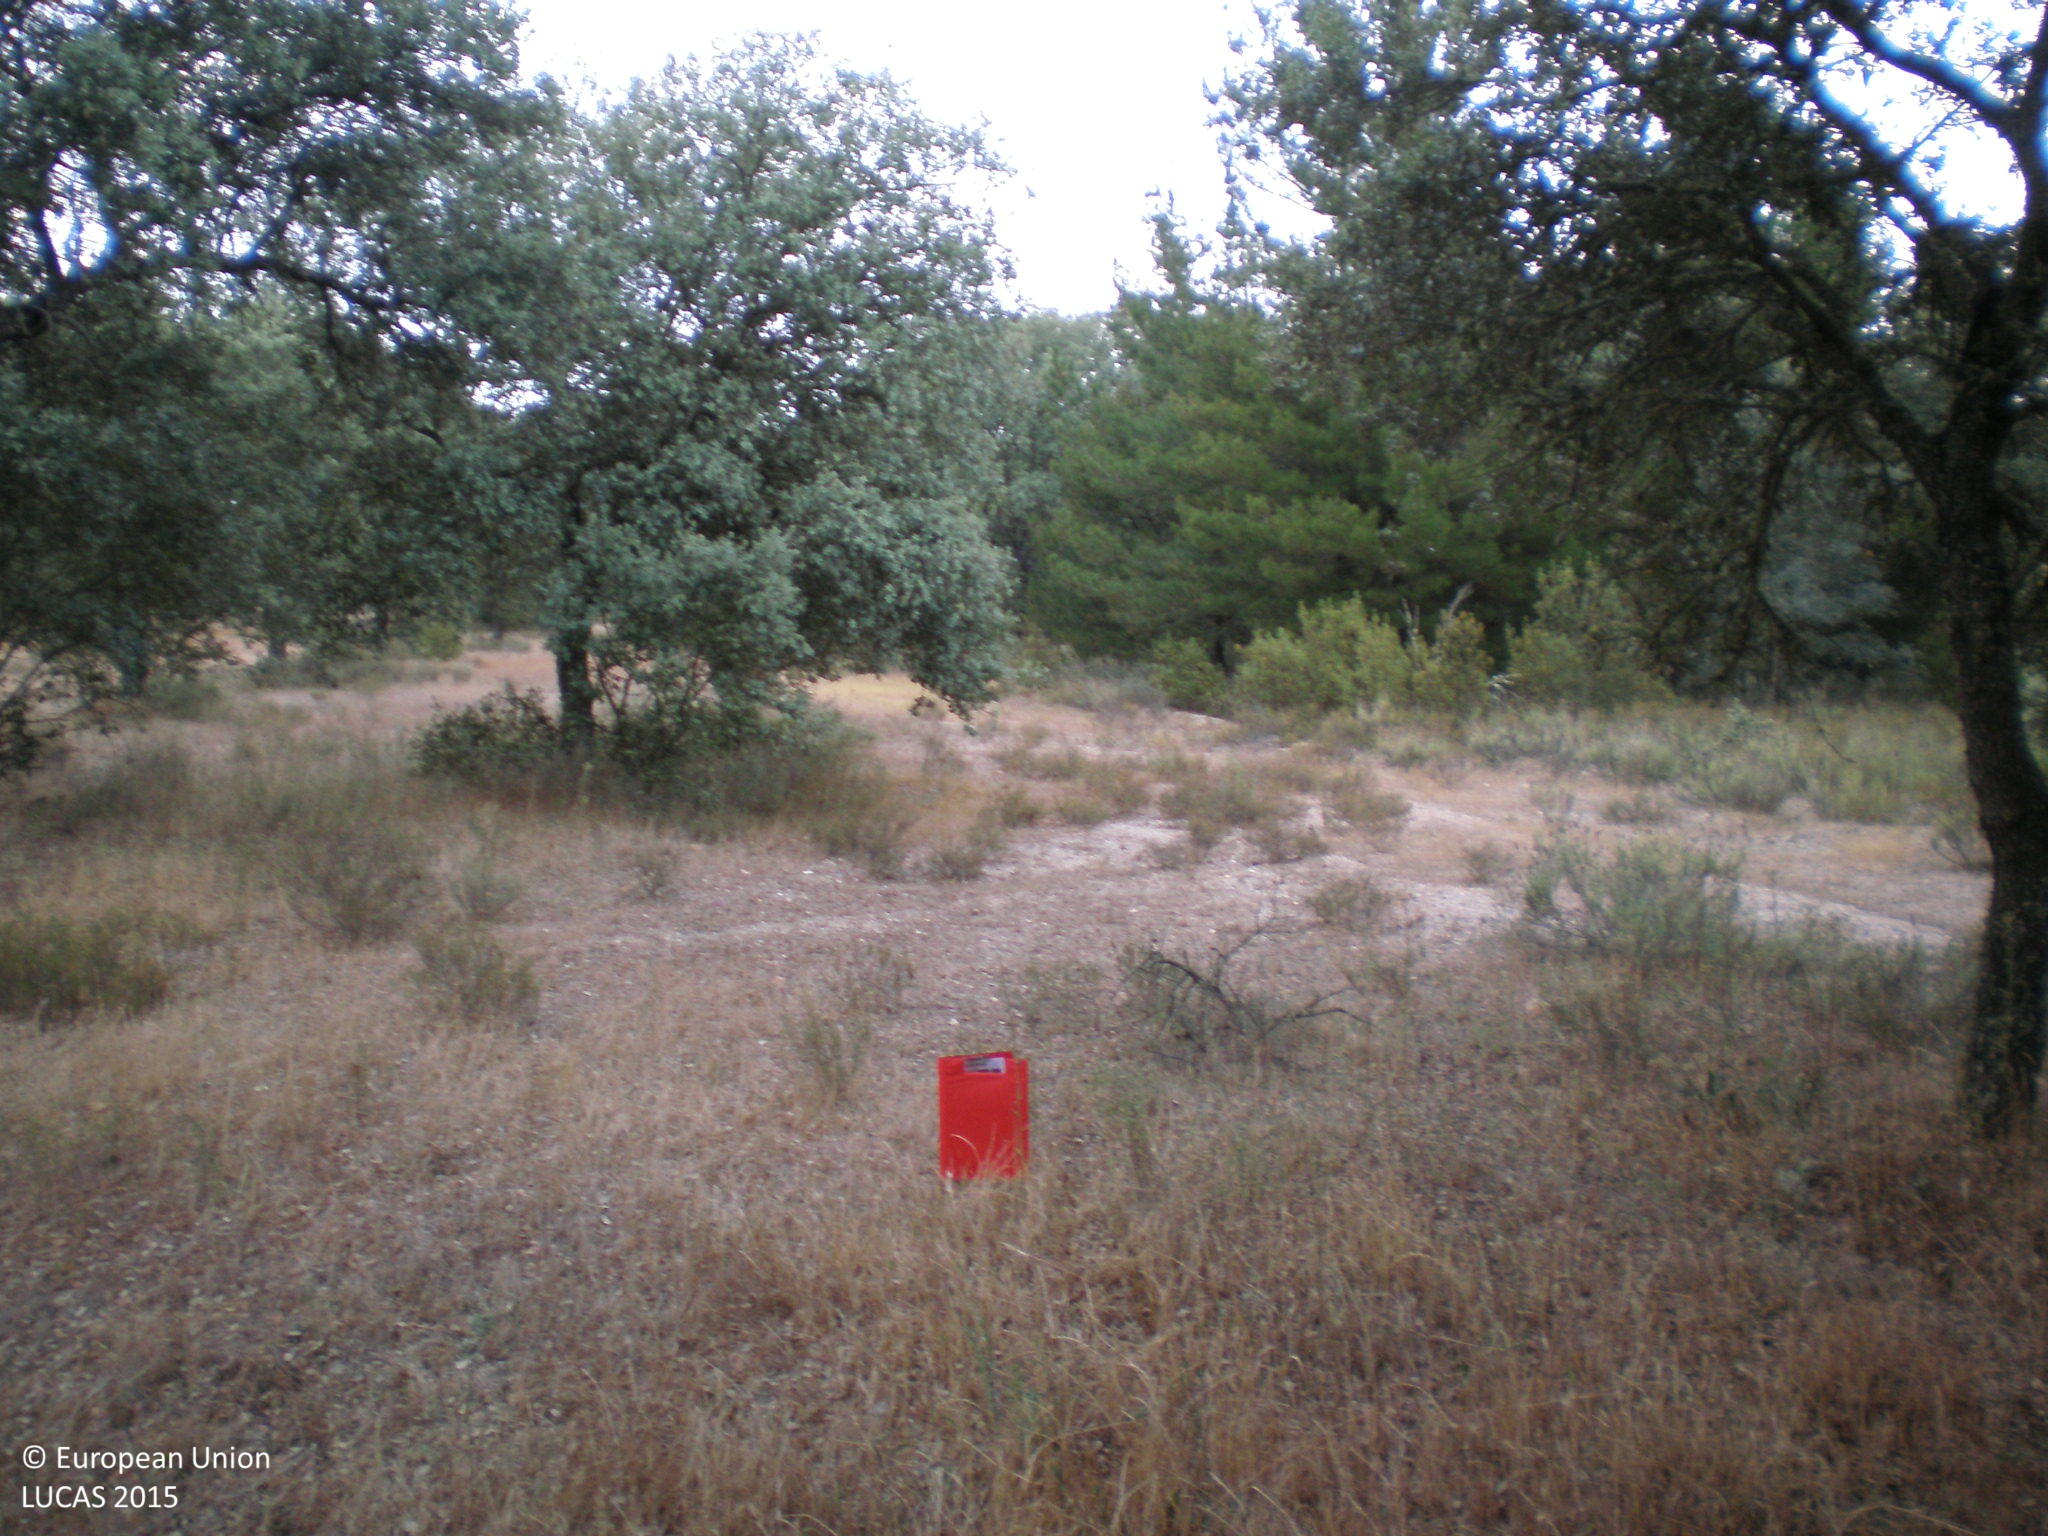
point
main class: Woodland
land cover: Broadleaved woodland
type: broadleaved evergreen forest
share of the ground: 50 - 75 %
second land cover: Grassland without tree/shrub cover
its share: 25 - 50 %
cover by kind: broadleaved forest trees 60 %, herbaceous plants 40 %
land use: Forestry
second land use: Agriculture (excluding fallow land and kitchen gardens)
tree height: > 5 m
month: June
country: ES
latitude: 41.1301
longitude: -5.7941
